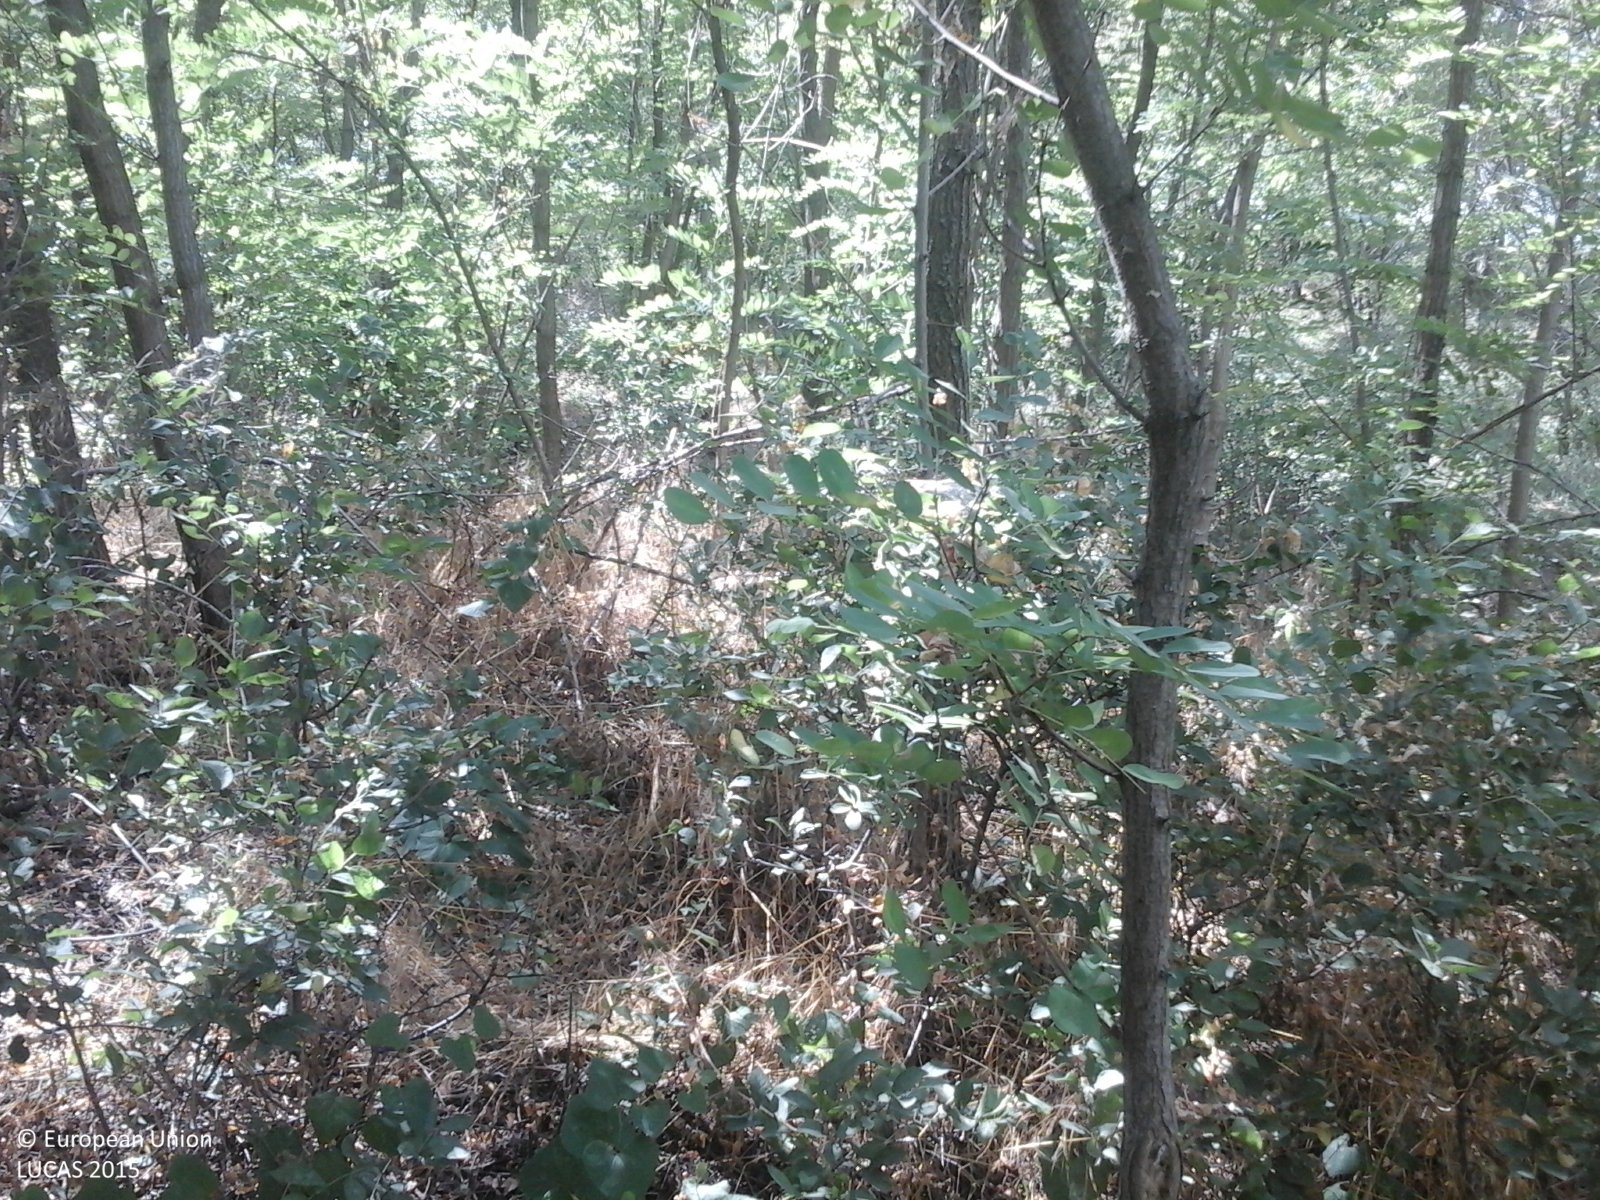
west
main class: Woodland
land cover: Broadleaved woodland
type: exotic forest
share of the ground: > 75 %
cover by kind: broadleaved forest trees 100 %
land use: Forestry
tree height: > 5 m
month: July
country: RO
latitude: 46.5420
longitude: 27.3322
